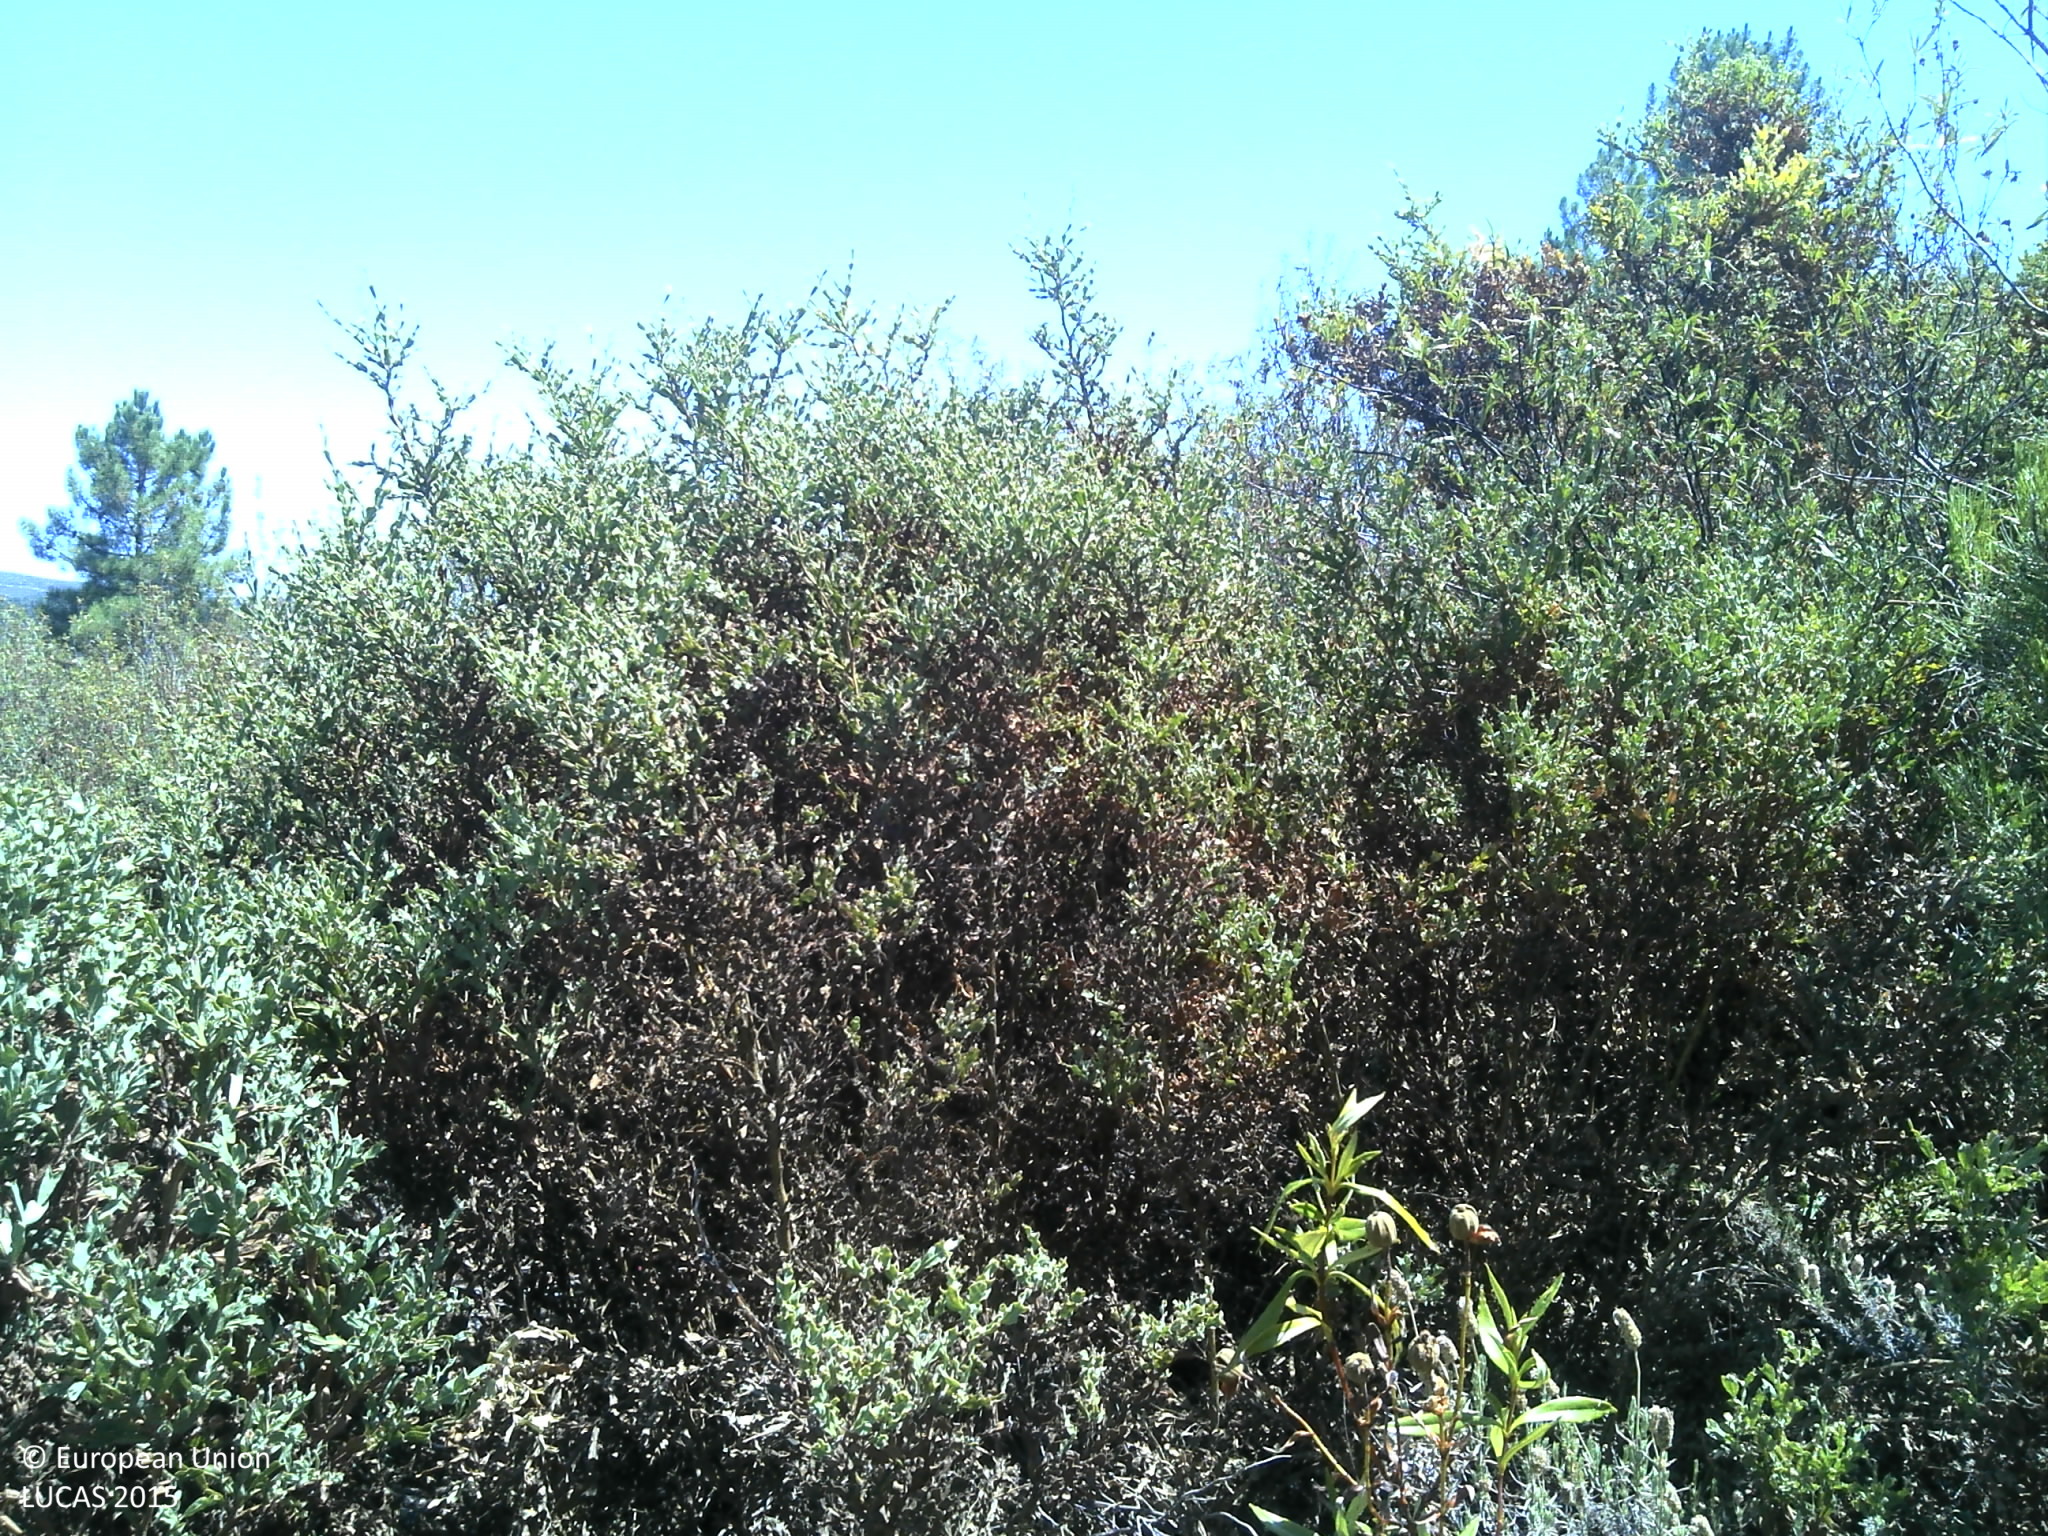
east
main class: Shrubland
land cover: Shrubland with sparse tree cover
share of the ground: > 75 %
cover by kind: shrubs 80 %, unconsolidated bare surface 15 %, coniferous forest trees 5 %
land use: Forestry
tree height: > 5 m
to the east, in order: Shrubland with sparse tree cover; Shrubland without tree cover; Shrubland with sparse tree cover; Shrubland without tree cover; Pine dominated coniferous woodland; Olive groves; Tracks; Olive groves; Tracks; Olive groves
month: July
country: PT
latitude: 41.3647
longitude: -7.3478
